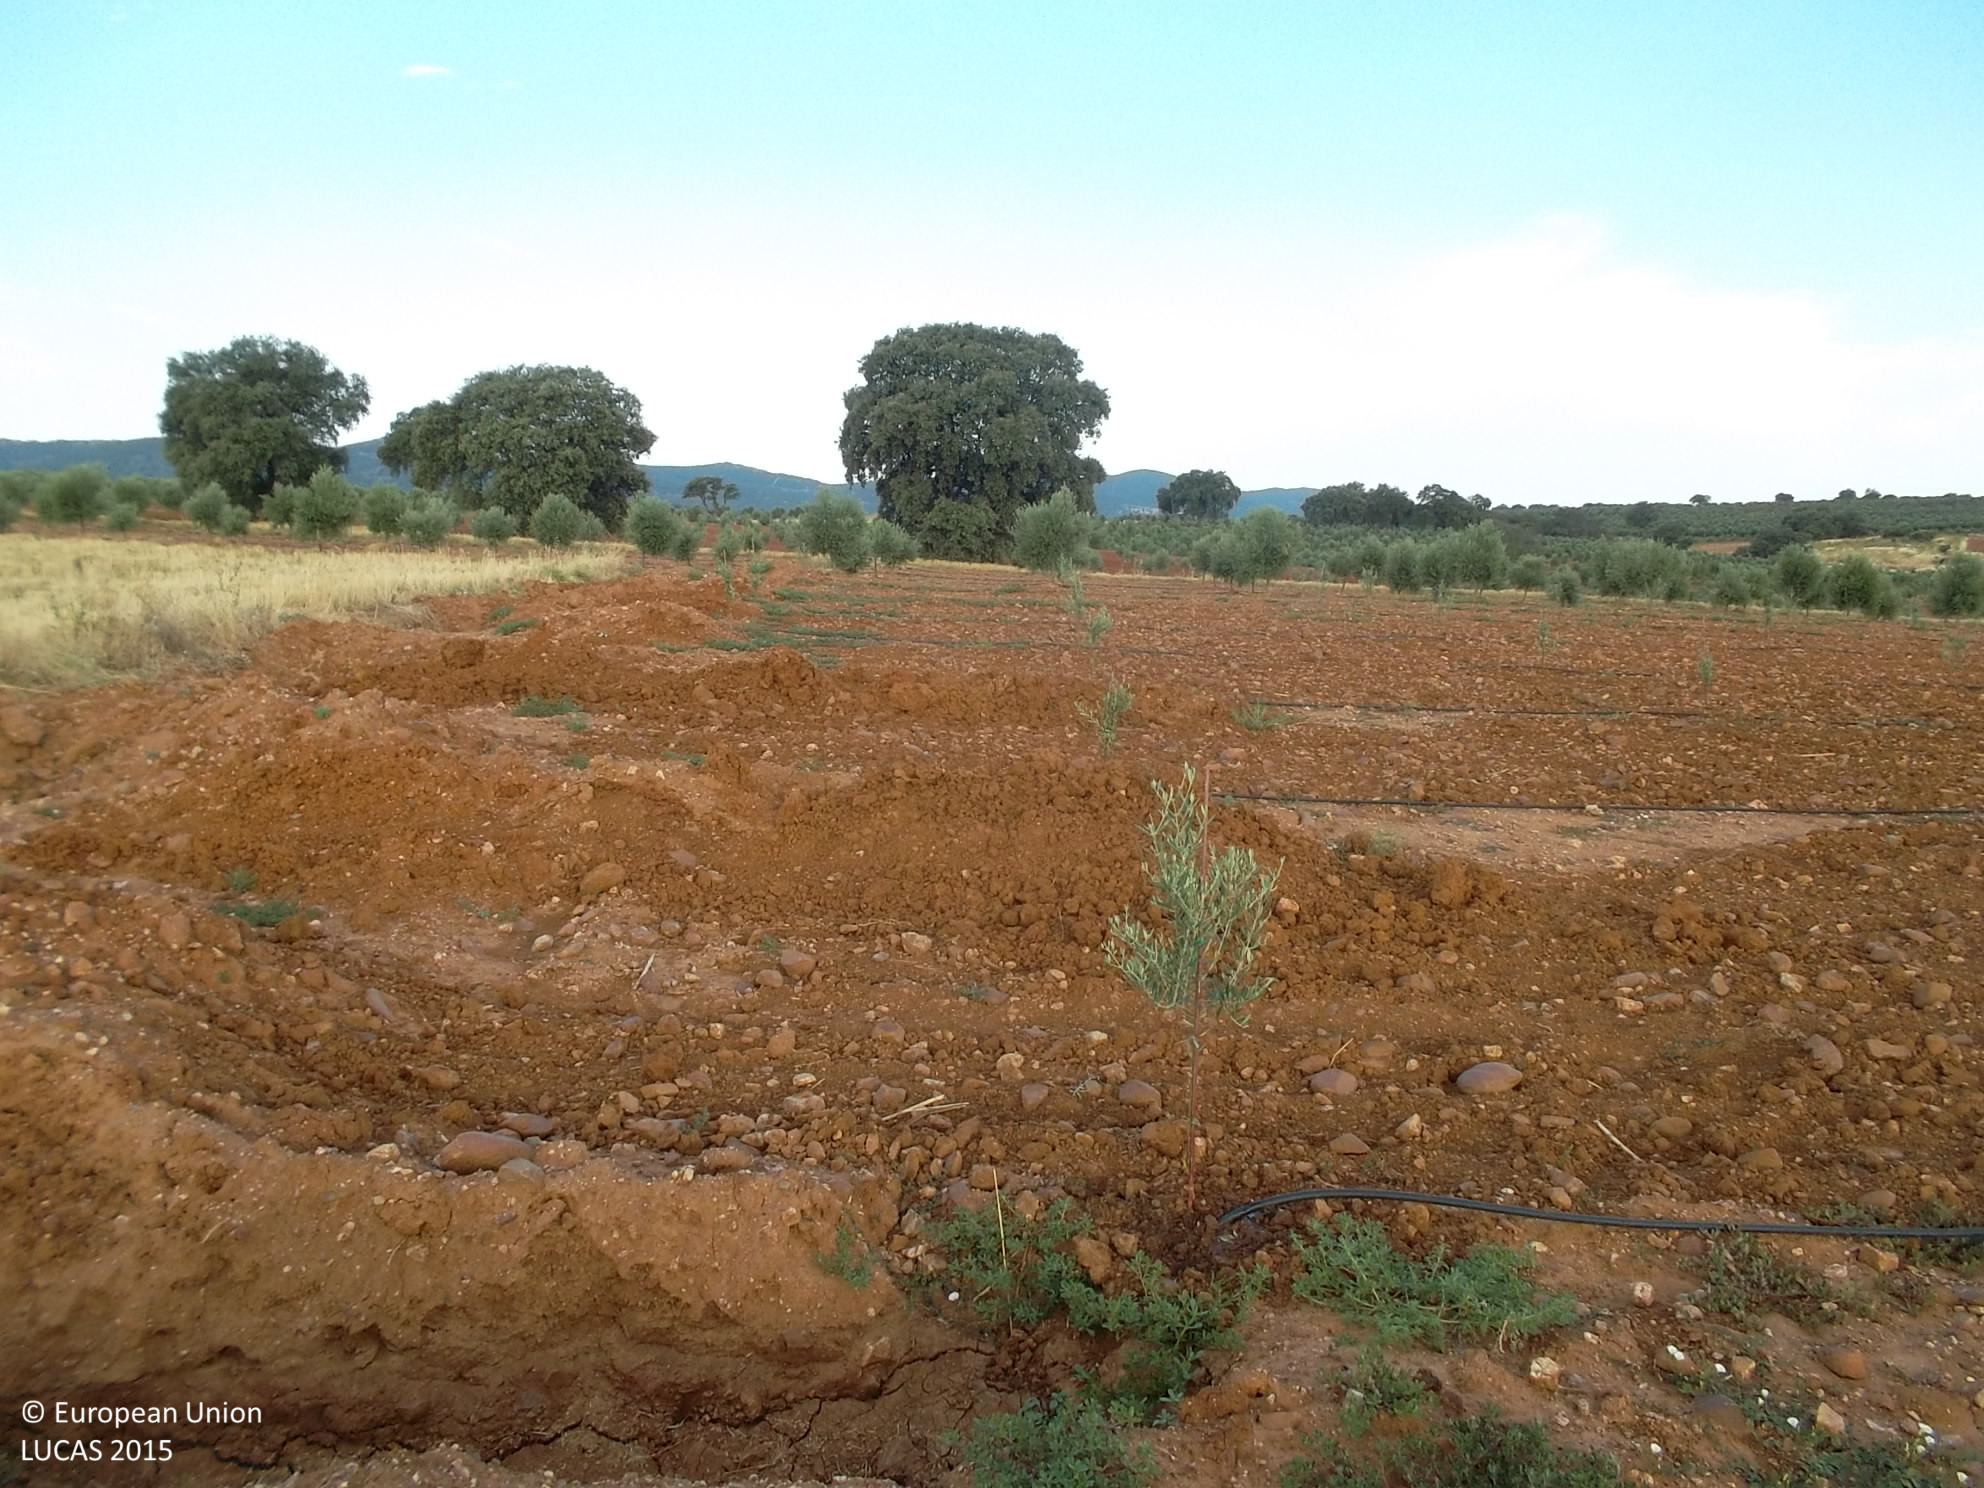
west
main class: Cropland
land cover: Olive groves
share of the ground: 10 - 25 %
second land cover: Other bare soil
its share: > 75 %
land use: Agriculture (excluding fallow land and kitchen gardens)
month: July
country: ES
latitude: 38.6002
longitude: -5.4105
